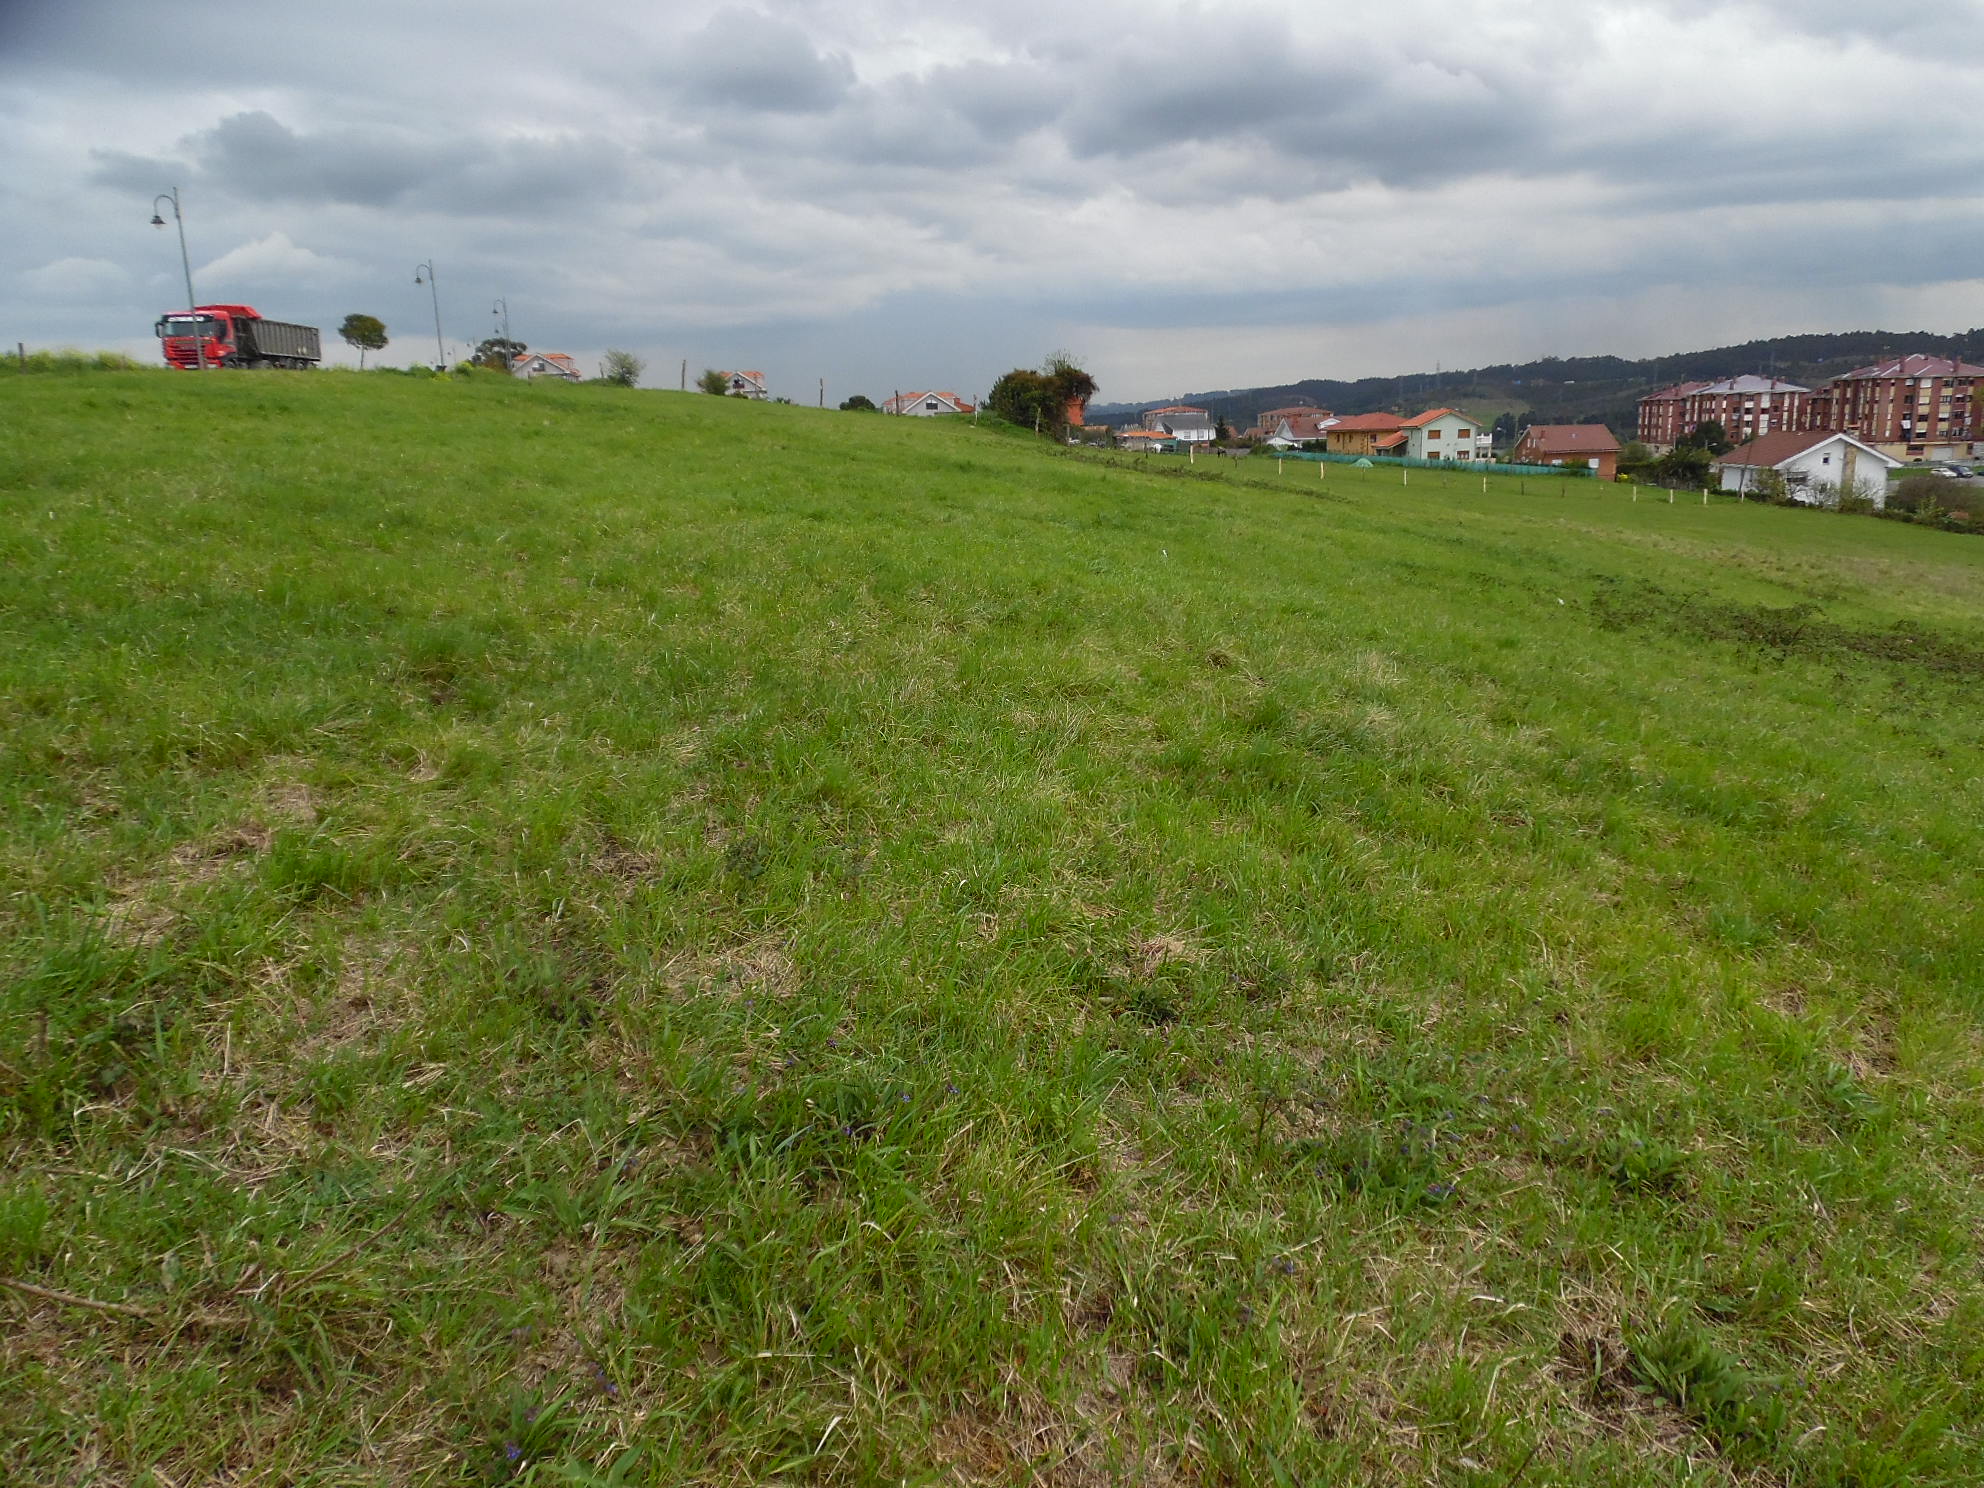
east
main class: Grassland
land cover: Grassland without tree/shrub cover
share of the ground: > 75 %
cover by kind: herbaceous plants 100 %
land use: Agriculture (excluding fallow land and kitchen gardens)
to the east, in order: Grassland without tree/shrub cover; Fences; Grassland without tree/shrub cover; Fences; Artificial constructions in urban areas
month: April
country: ES
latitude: 43.5383
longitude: -5.8940
